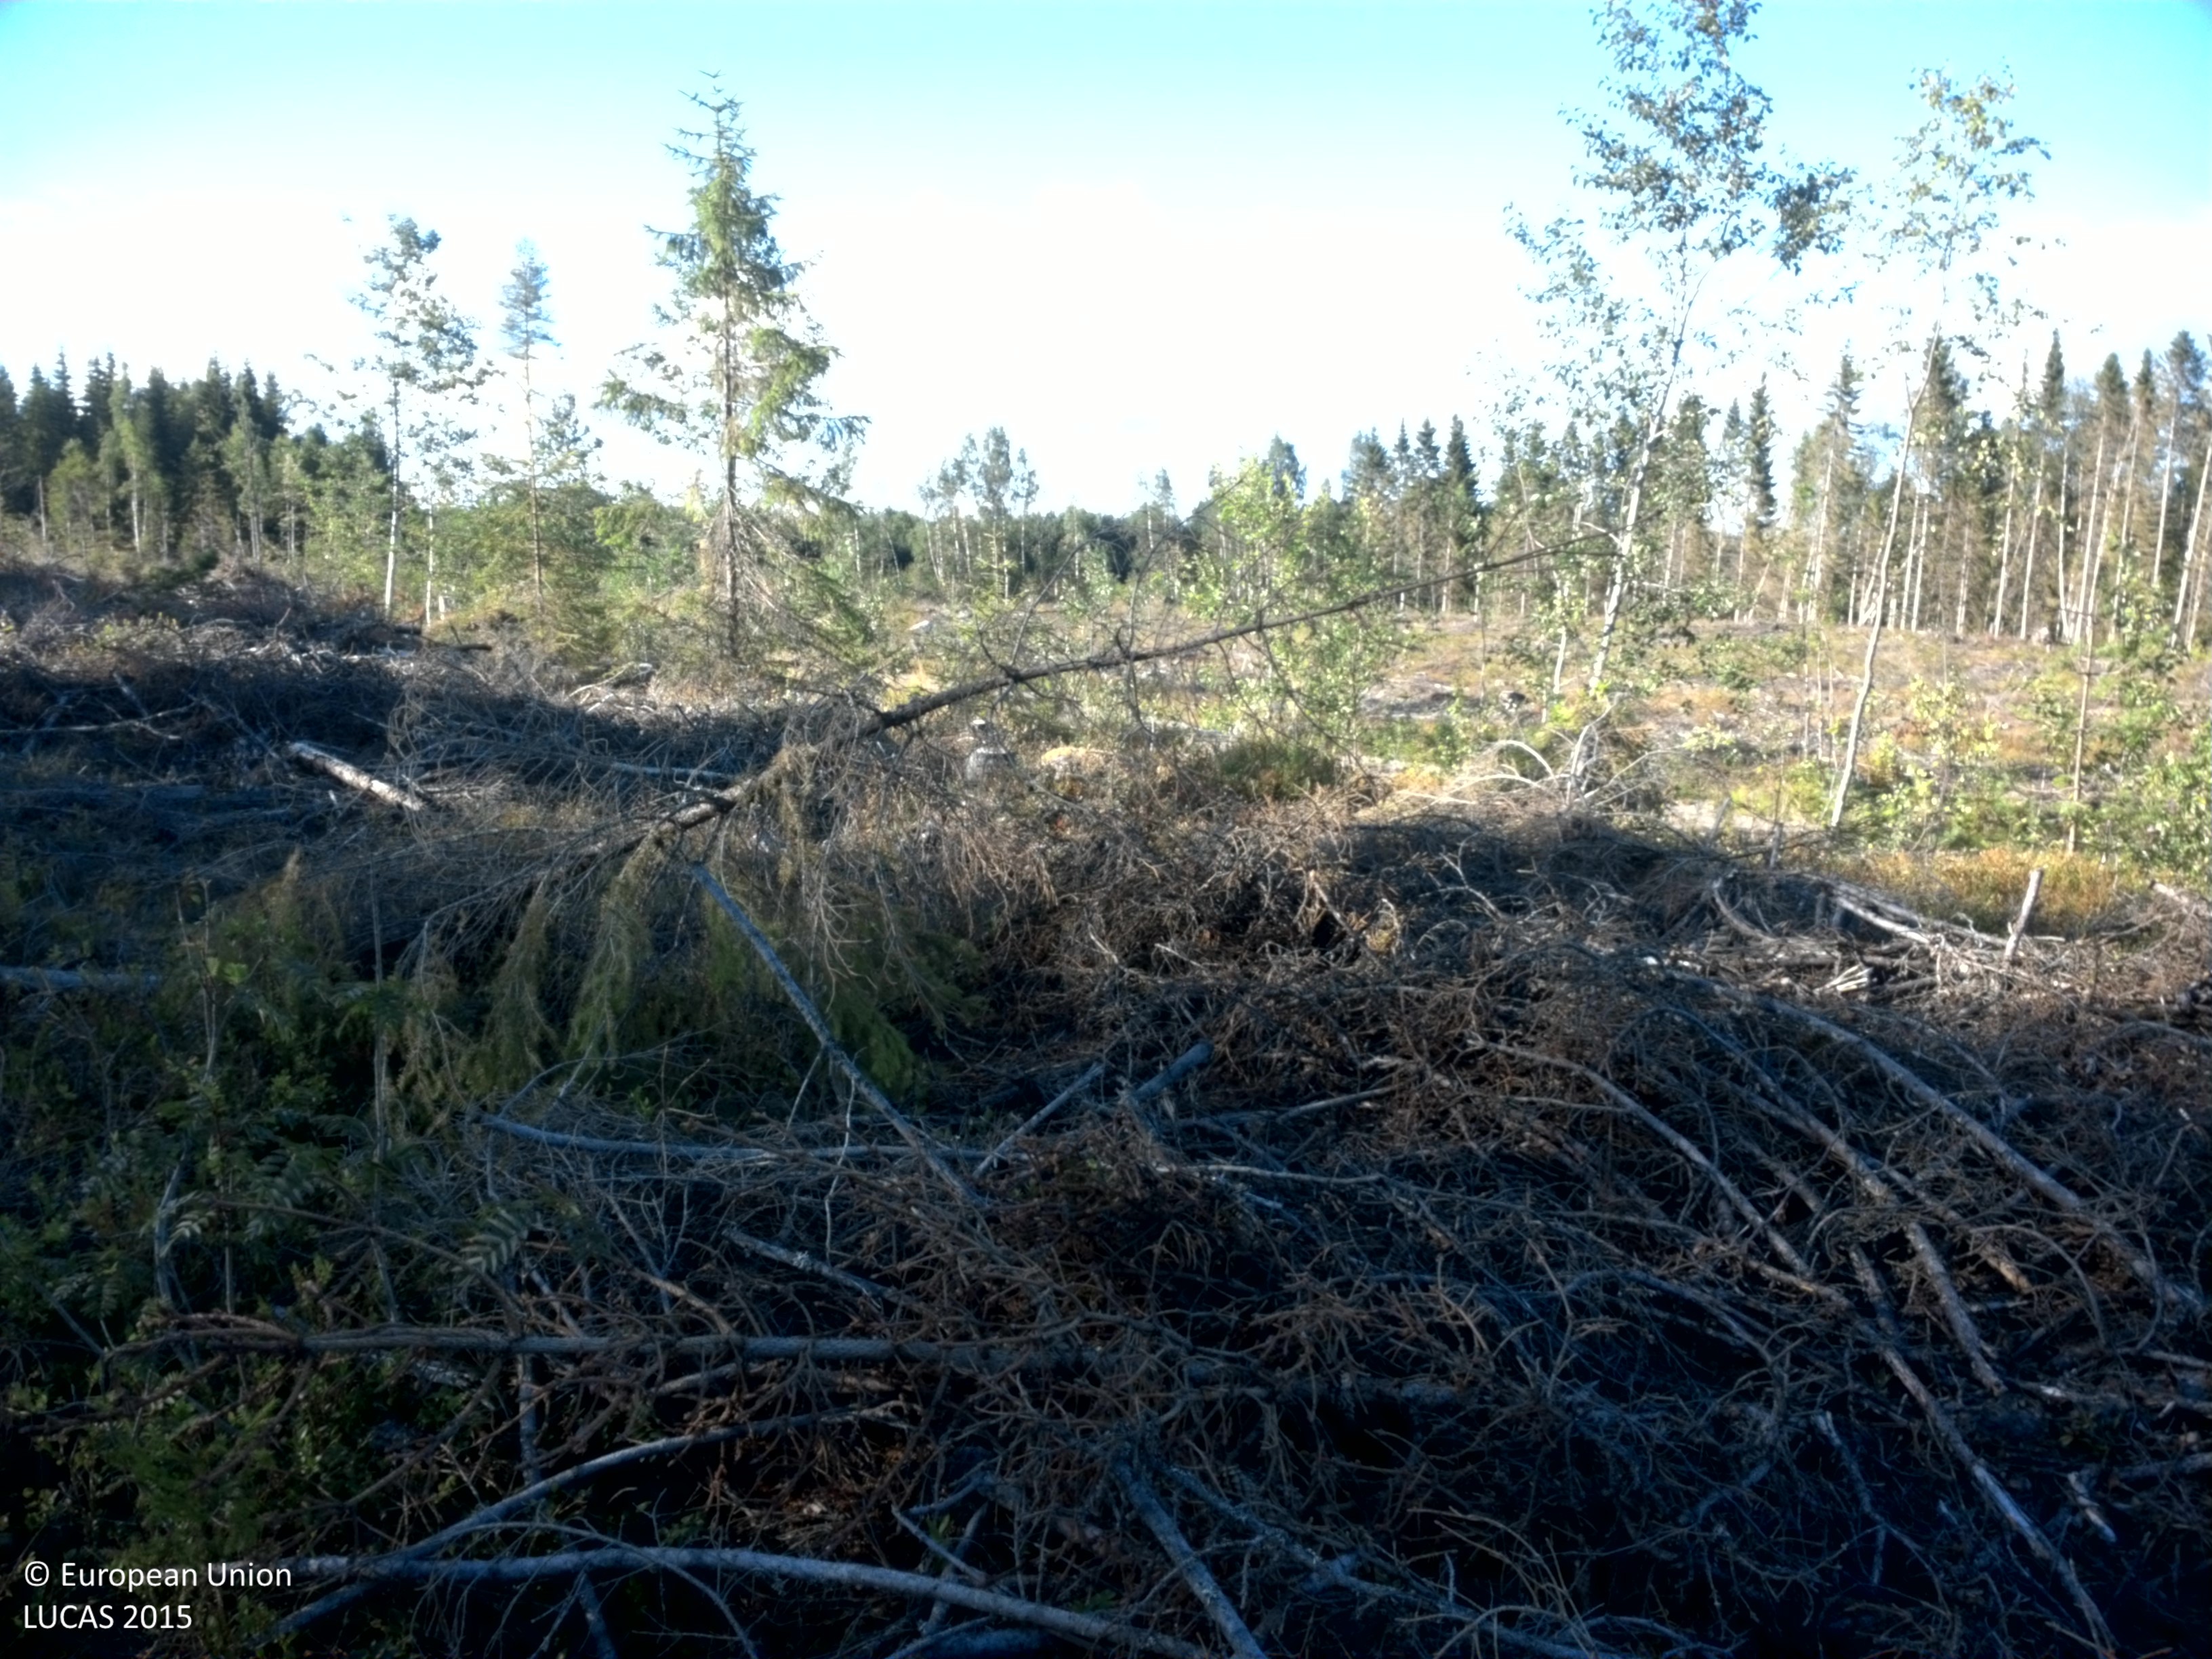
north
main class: Shrubland
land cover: Shrubland with sparse tree cover
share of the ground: > 75 %
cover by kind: shrubs 90 %, coniferous forest trees 5 %, herbaceous plants 5 %
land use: Forestry
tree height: < 5 m
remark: Clear cut
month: August
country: SE
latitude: 64.5674
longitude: 20.9364
